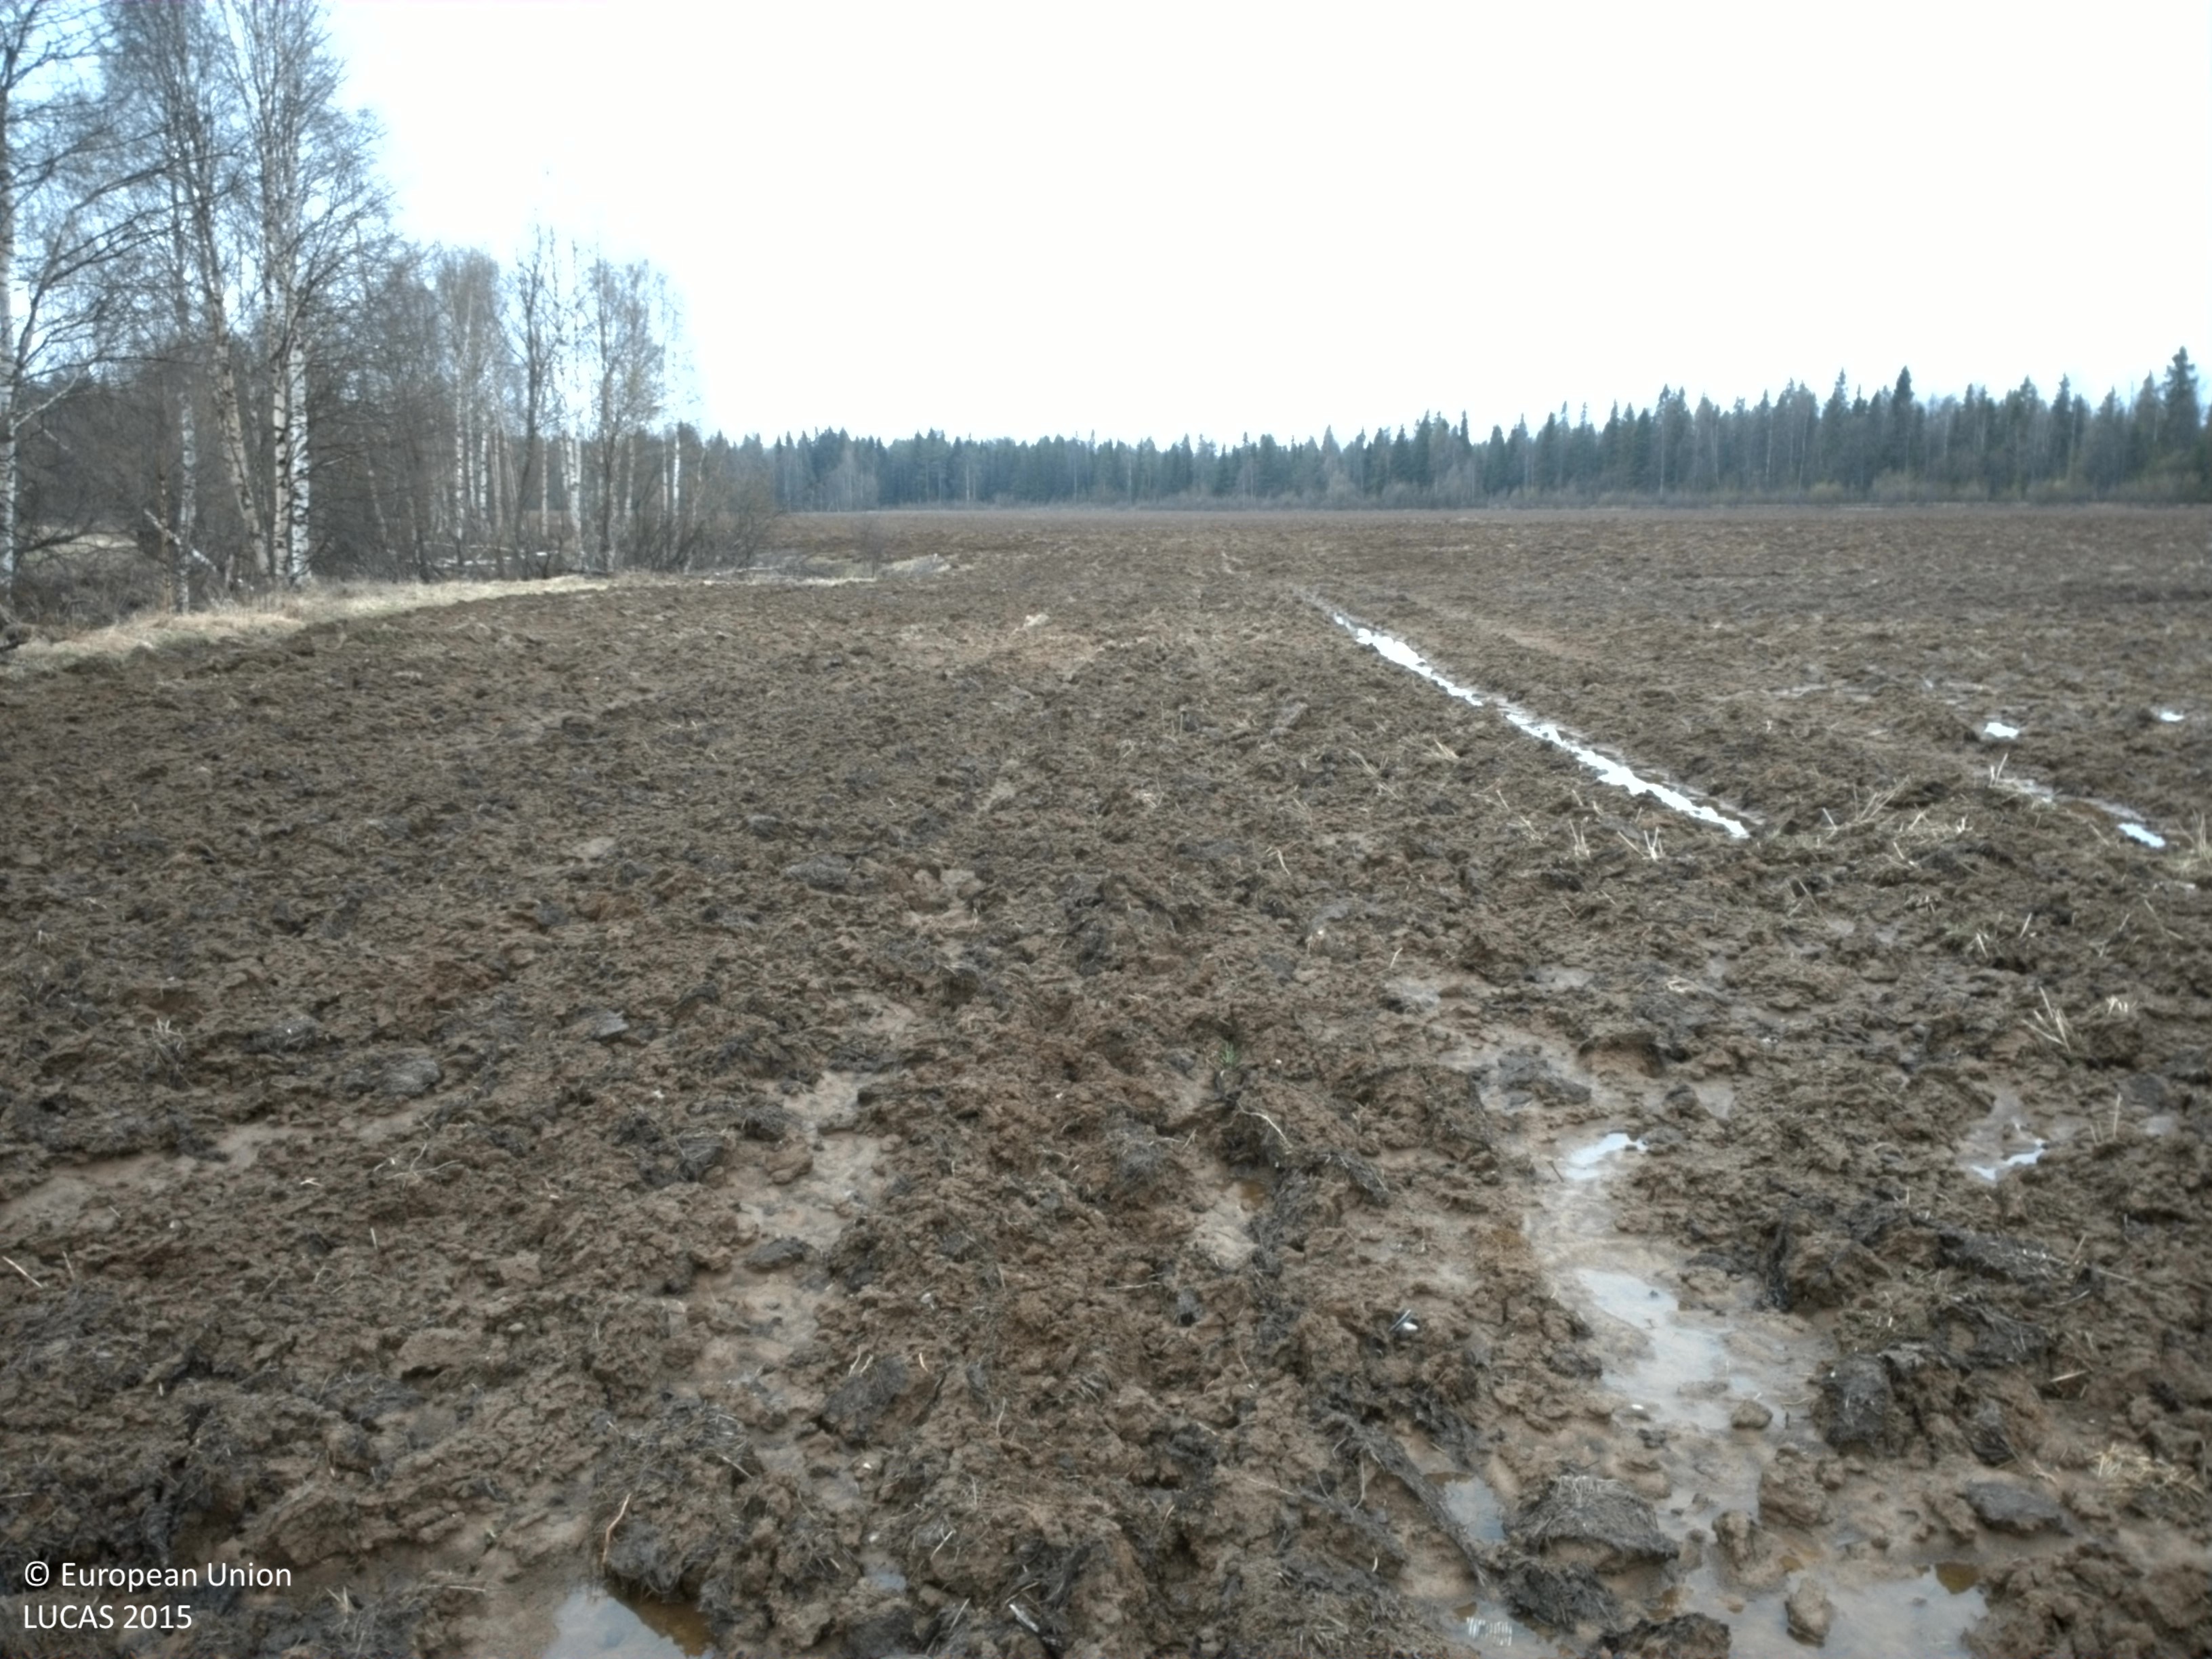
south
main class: Cropland
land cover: Temporary grasslands
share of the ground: > 75 %
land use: Agriculture (excluding fallow land and kitchen gardens)
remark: Tilled/Sowed
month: May
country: SE
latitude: 65.8613
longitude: 23.0254
